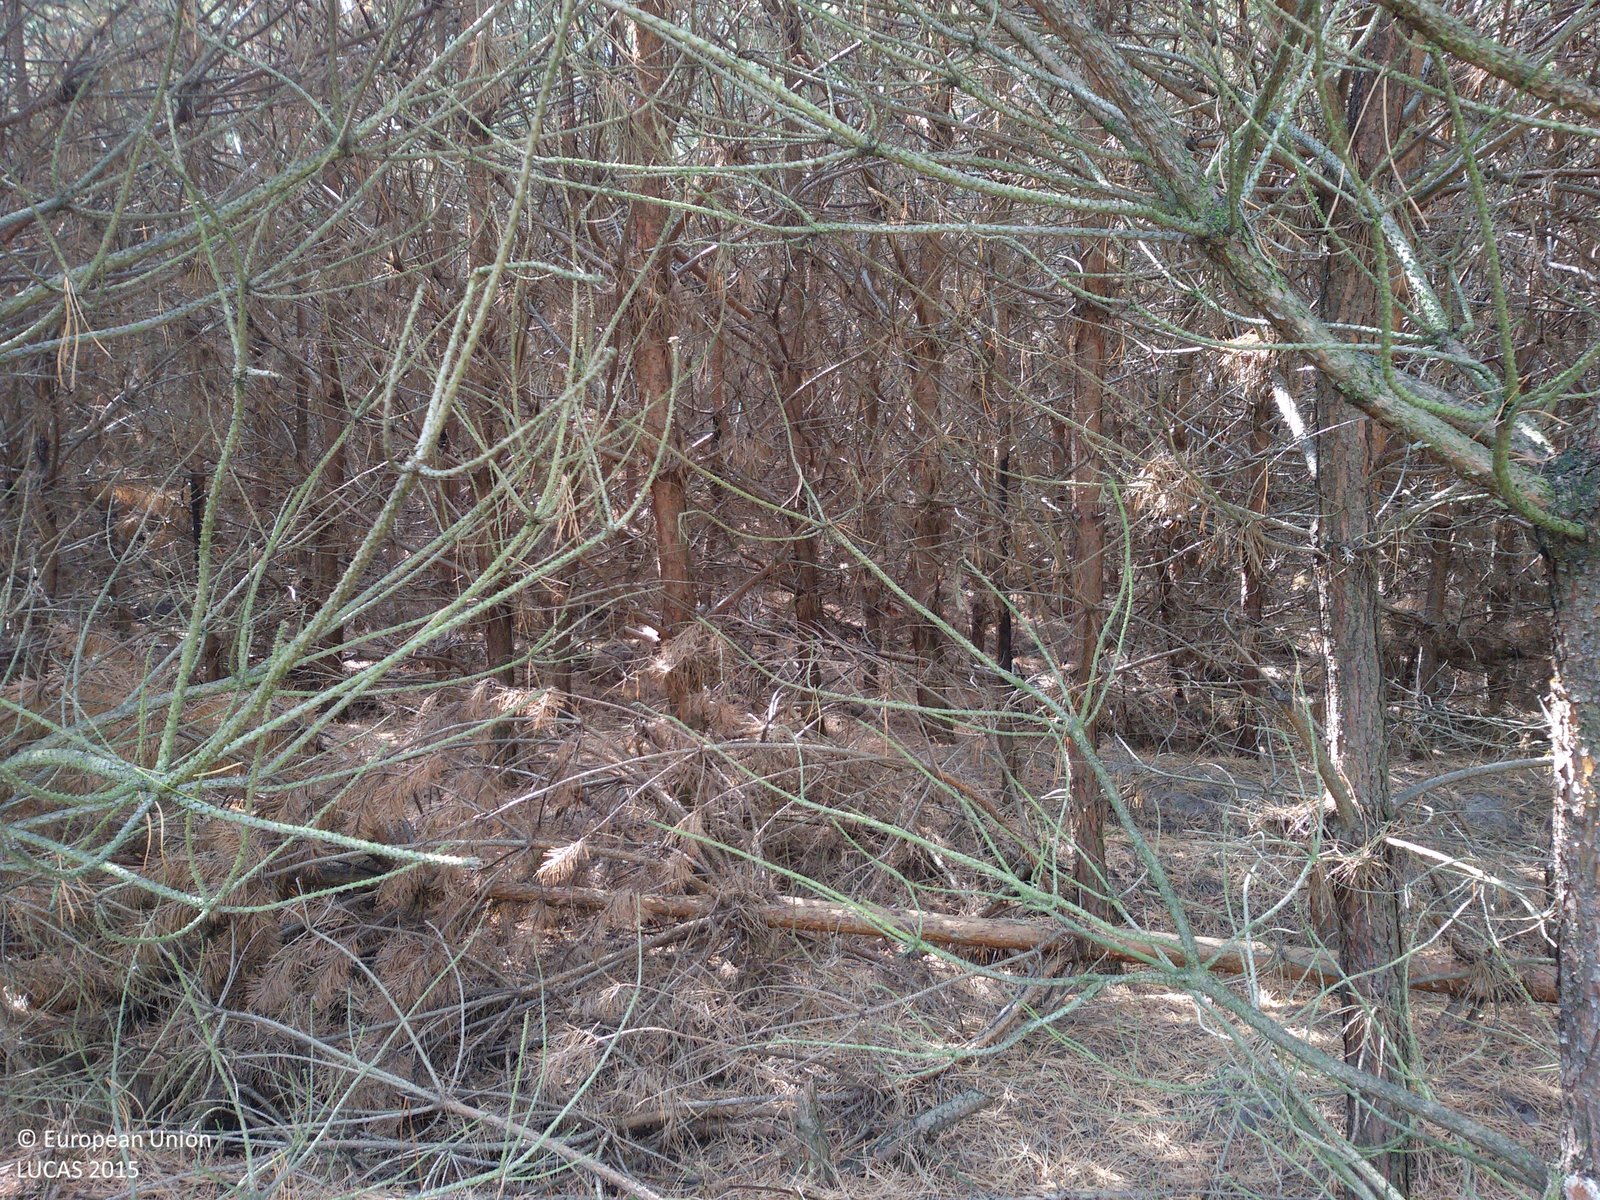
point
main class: Woodland
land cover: Pine dominated coniferous woodland
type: hemiboreal forest and nemoral coniferous forest and mixed broadleaved-coniferous forest
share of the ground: > 75 %
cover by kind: coniferous forest trees 90 %, herbaceous plants 5 %, unconsolidated bare surface 5 %
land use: Forestry
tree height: > 5 m
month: September
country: PL
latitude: 51.3766
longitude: 18.8577
